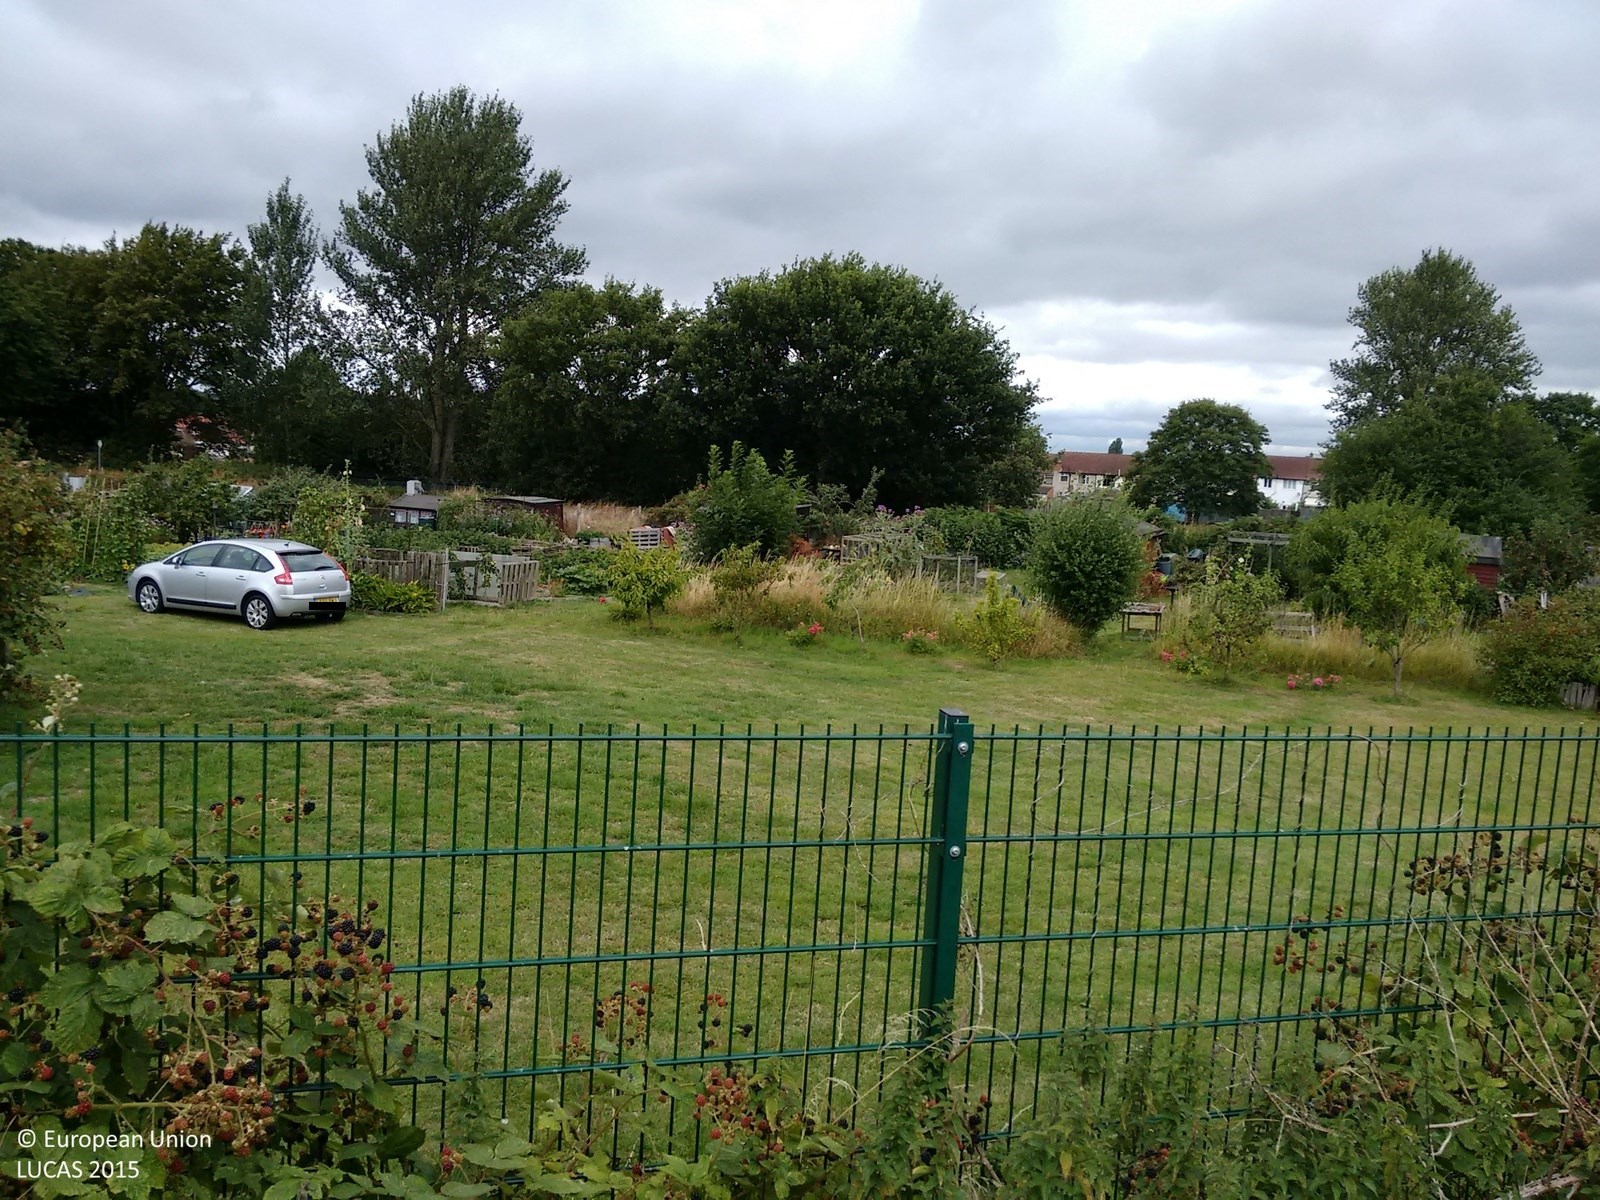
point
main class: Cropland
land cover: Other fresh vegetables
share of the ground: > 75 %
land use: Kitchen garden
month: August
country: GB
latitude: 51.4361
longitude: 0.0853
